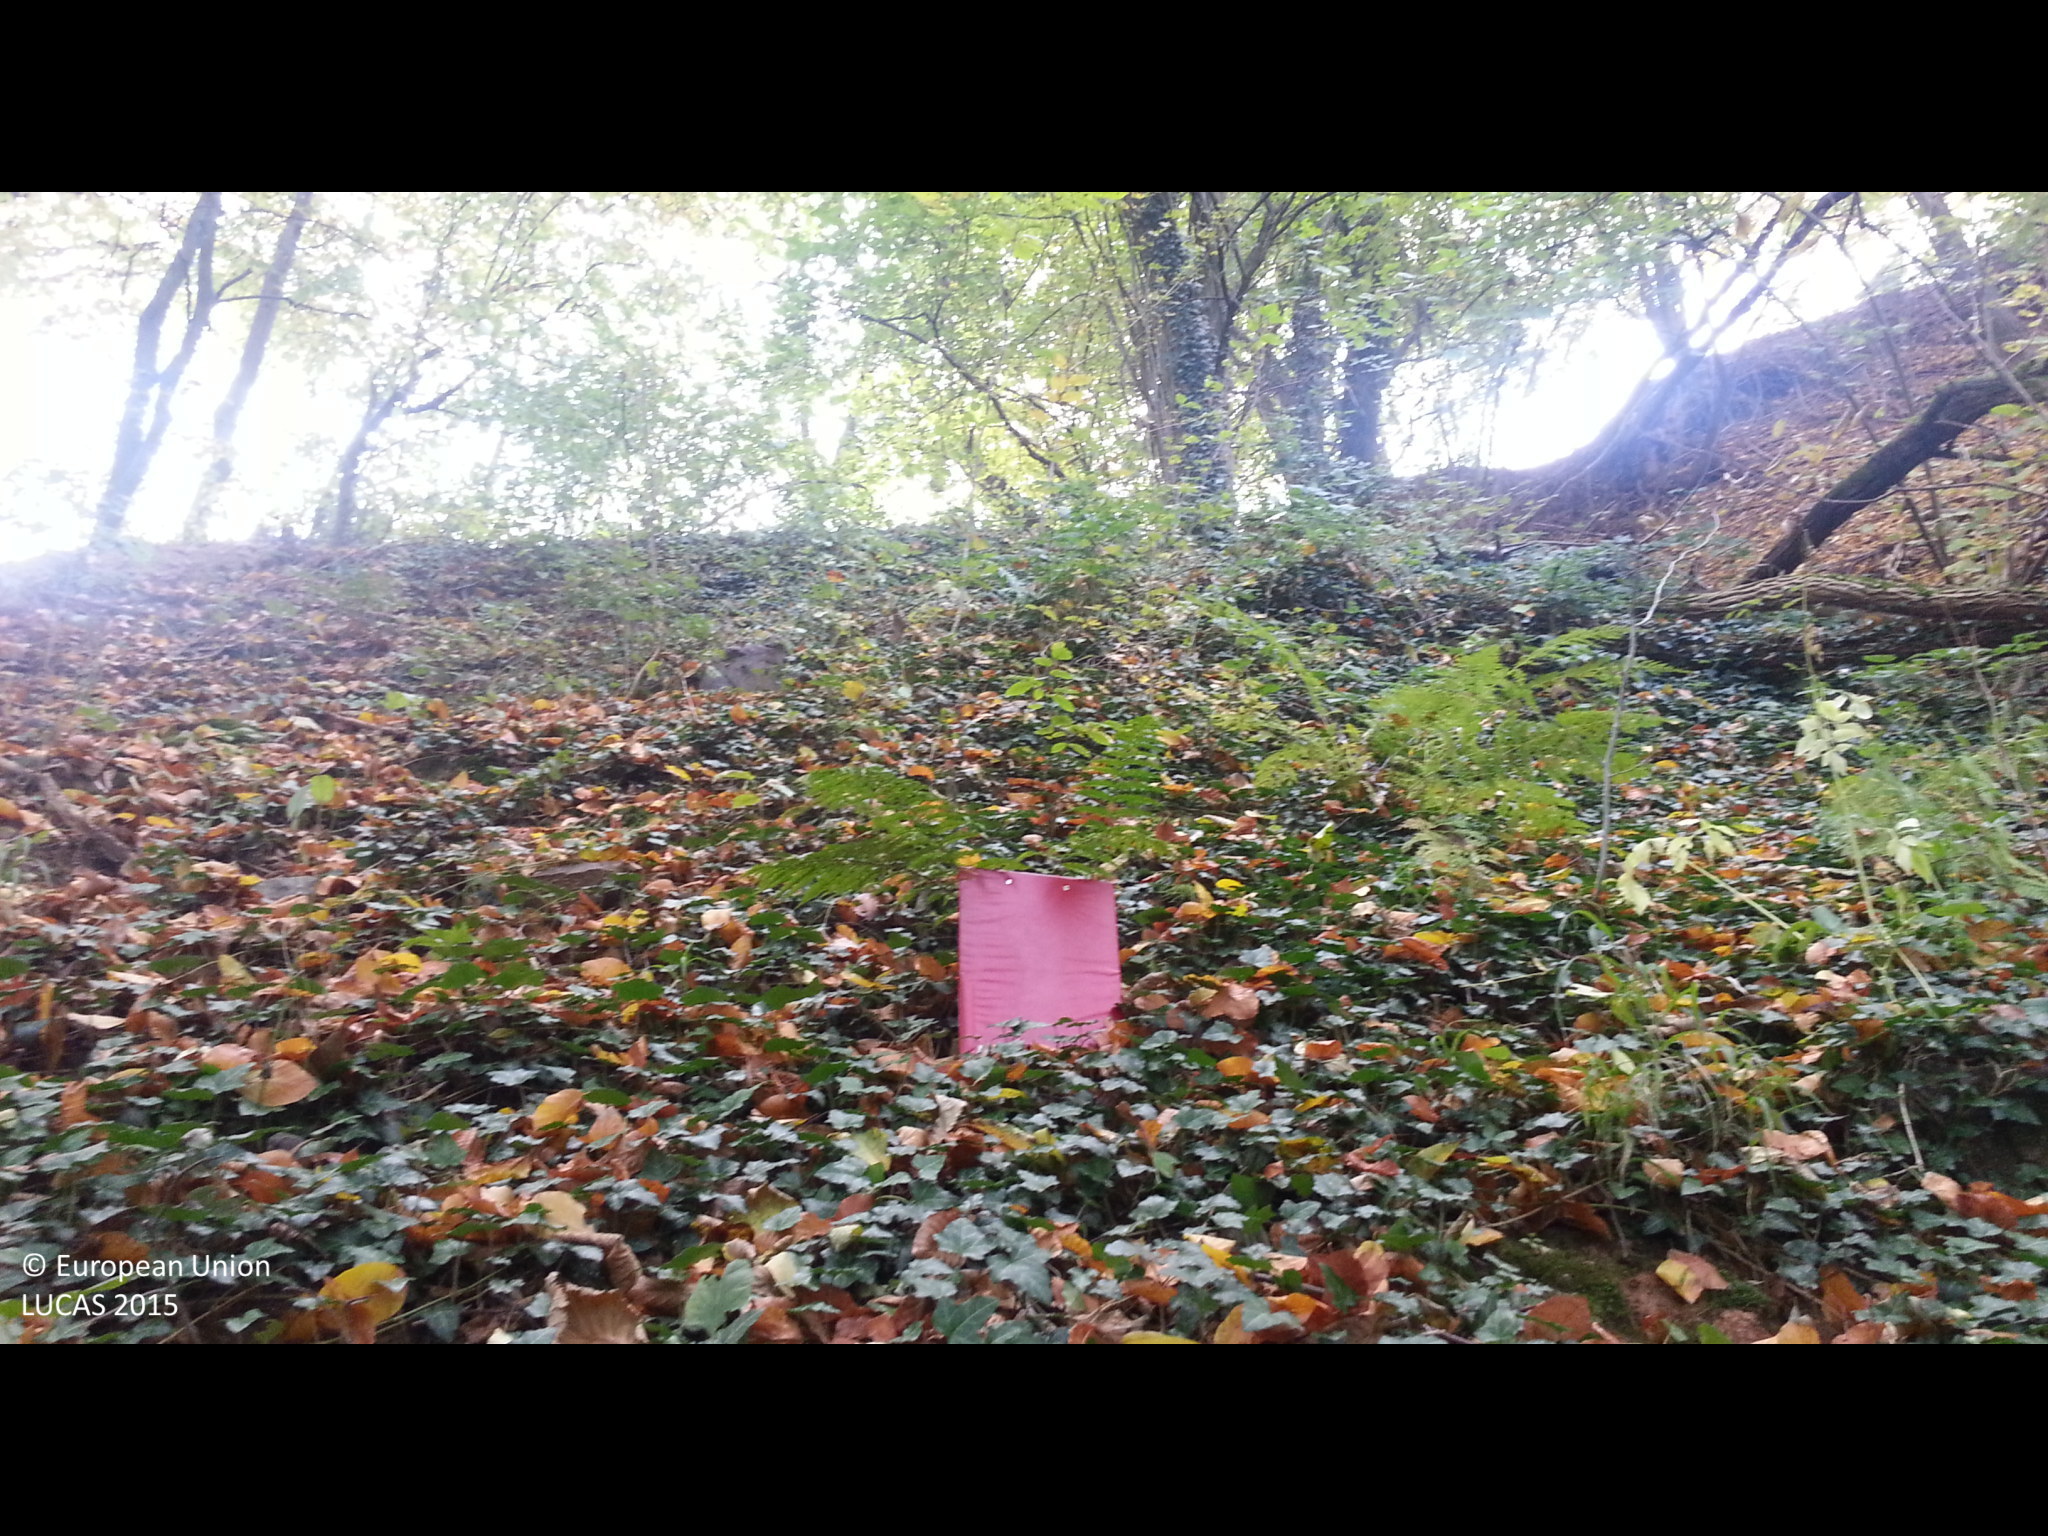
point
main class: Woodland
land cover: Broadleaved woodland
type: mesophytic deciduous forest
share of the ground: 50 - 75 %
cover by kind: broadleaved forest trees 55 %, consolidated bare surface 35 %, shrubs 5 %, herbaceous plants 5 %
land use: Forestry
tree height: > 5 m
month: November
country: BG
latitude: 42.8917
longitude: 23.9442
